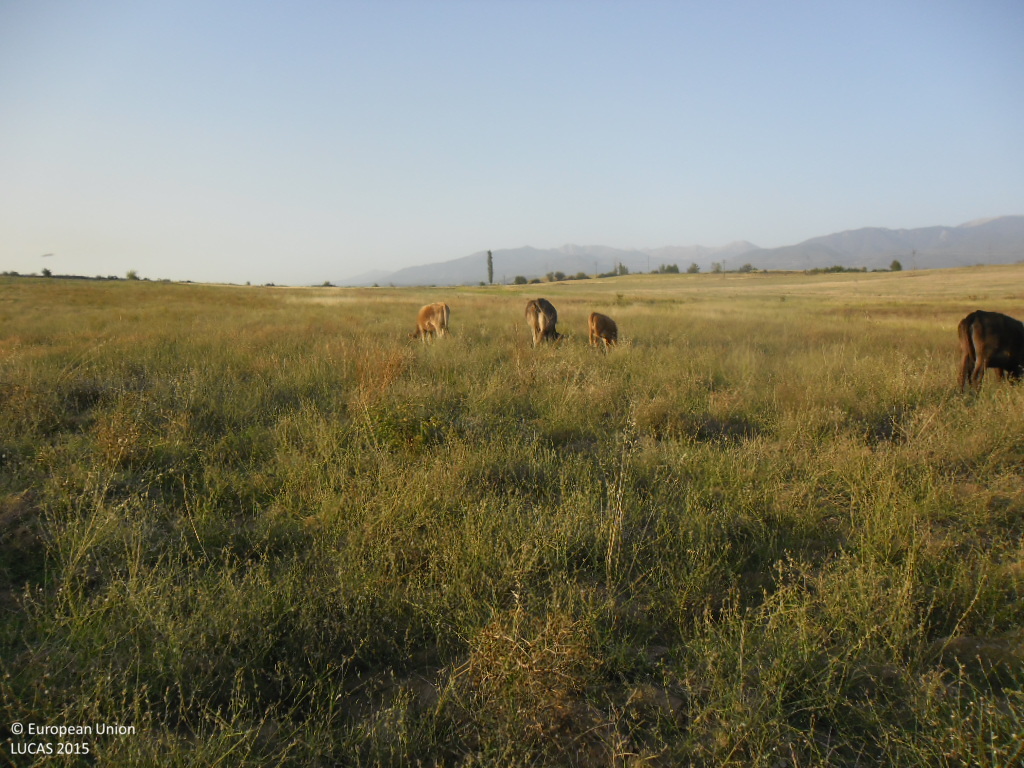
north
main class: Grassland
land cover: Grassland without tree/shrub cover
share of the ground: > 75 %
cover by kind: herbaceous plants 100 %
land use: Agriculture (excluding fallow land and kitchen gardens)
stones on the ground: < 10 %
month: September
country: BG
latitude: 41.5184
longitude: 23.2865
